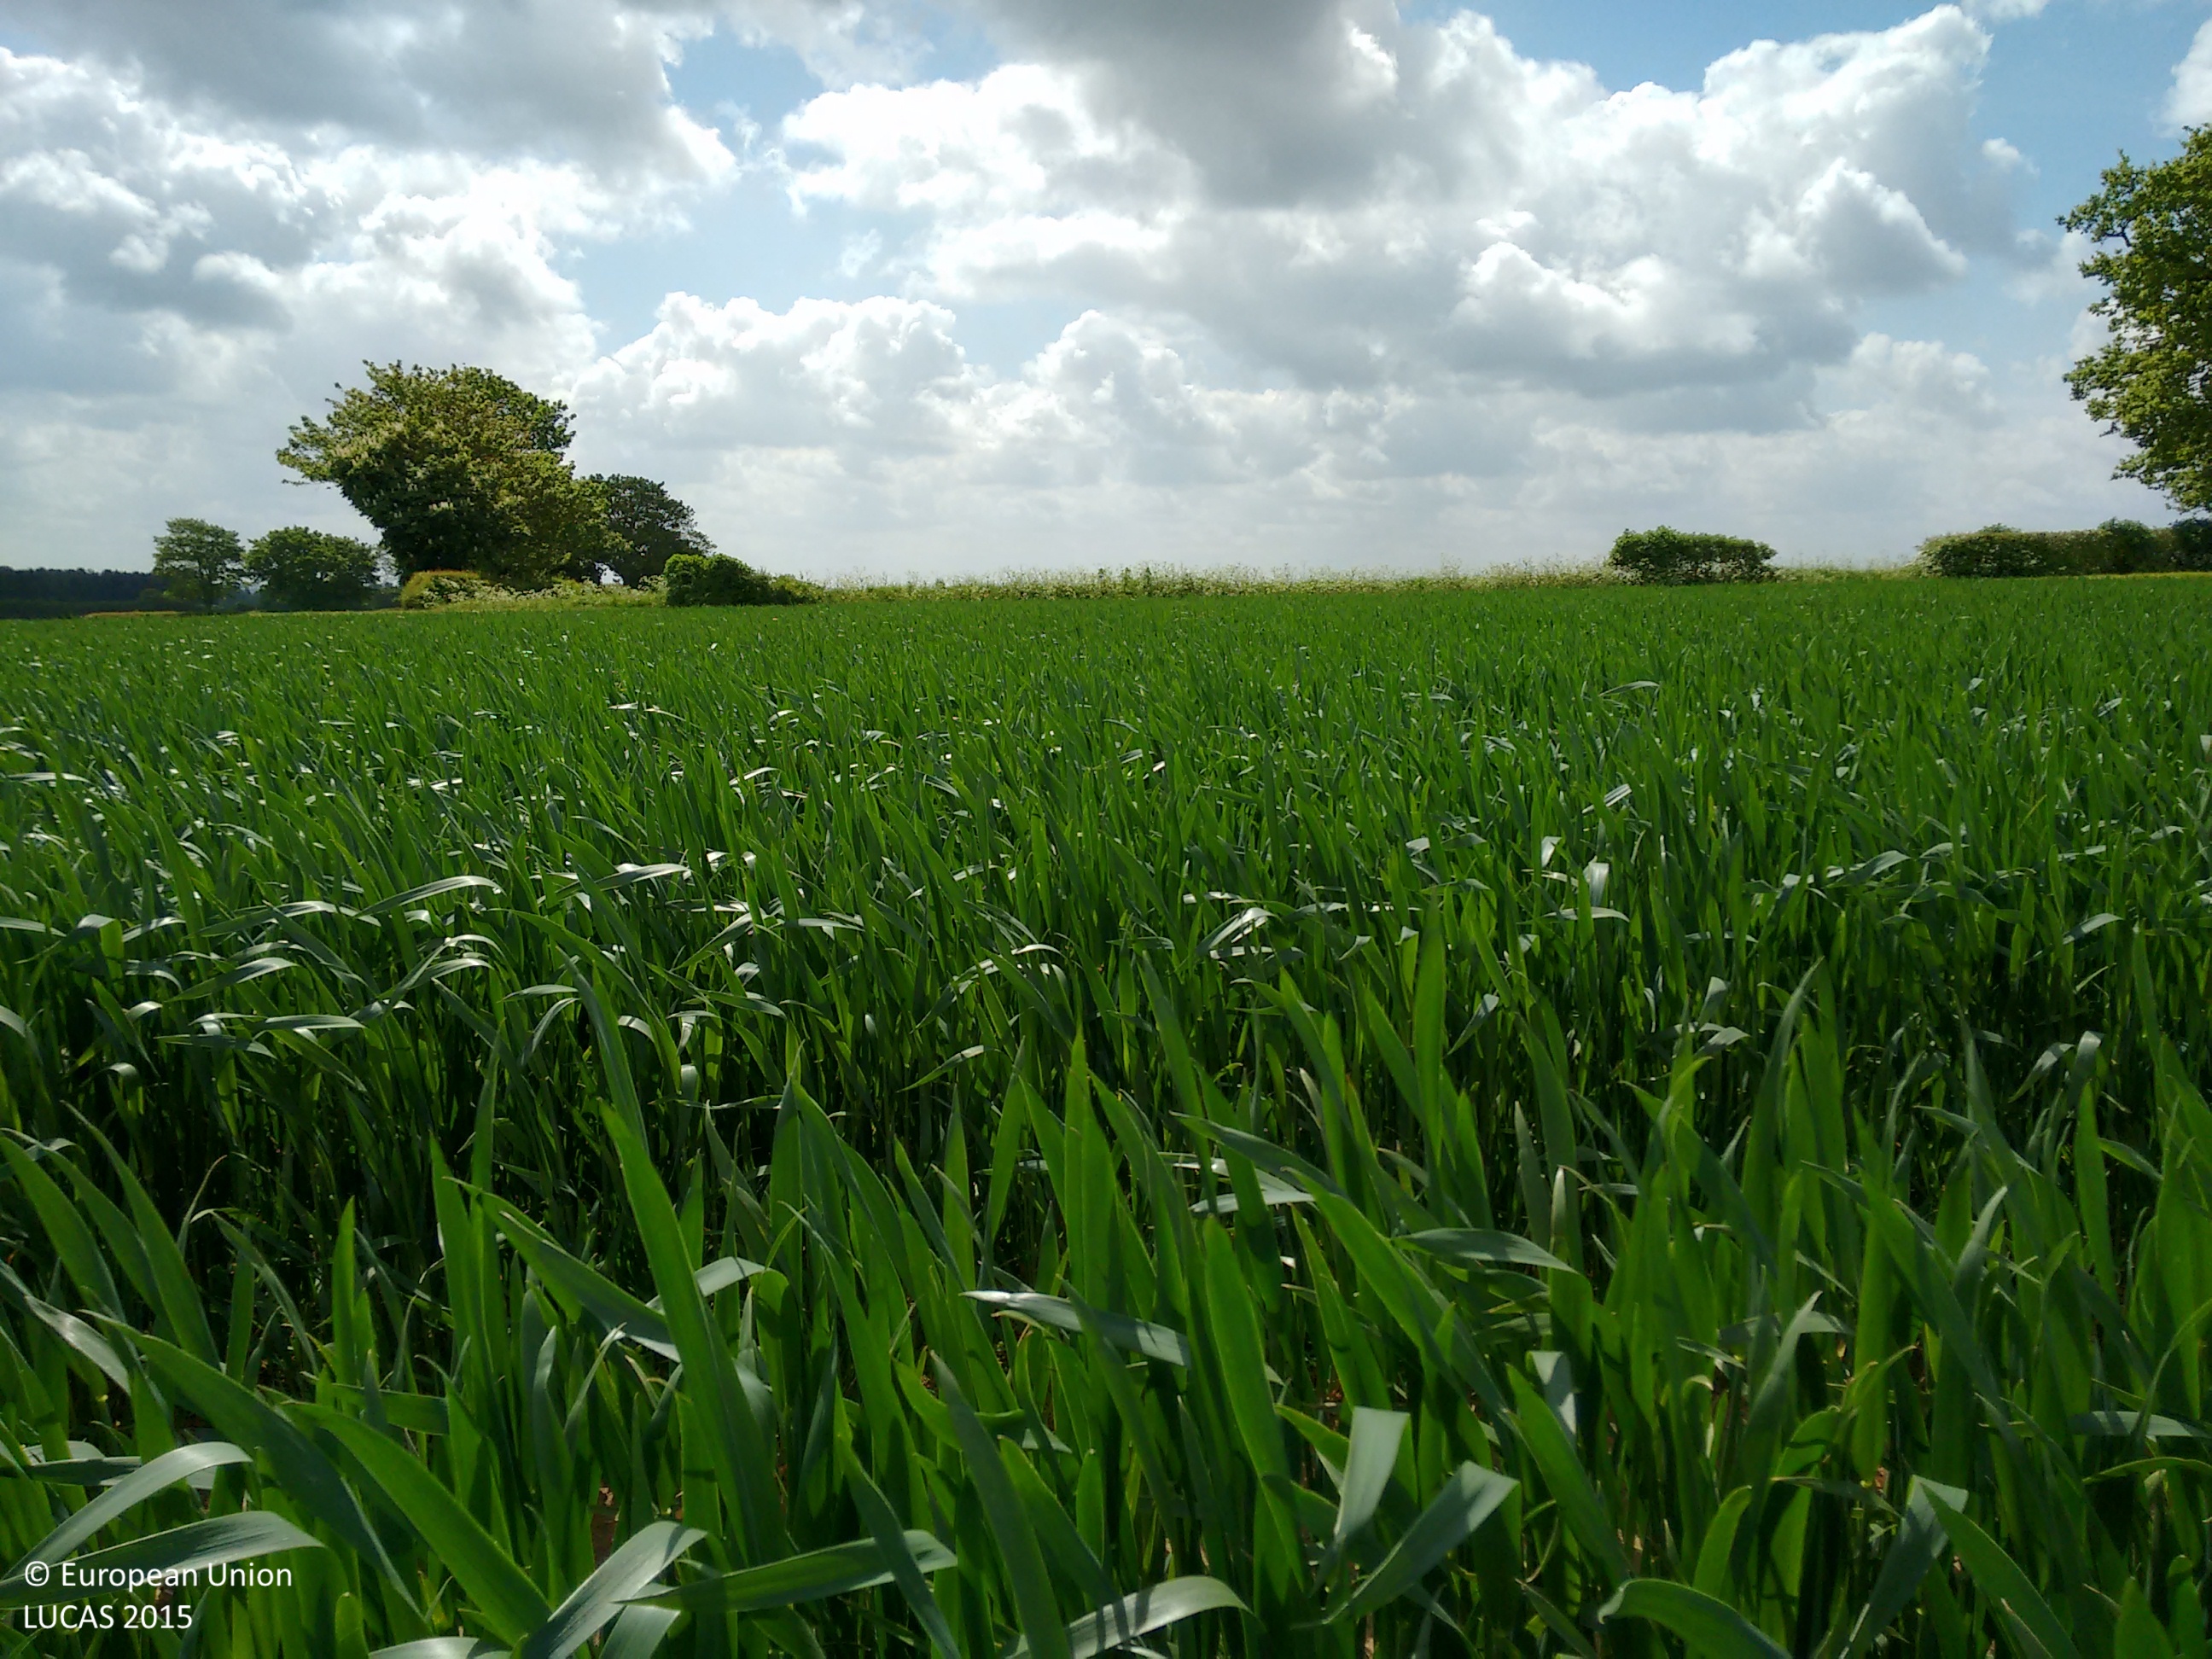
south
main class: Cropland
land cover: Common wheat
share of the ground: > 75 %
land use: Agriculture (excluding fallow land and kitchen gardens)
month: May
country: GB
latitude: 52.0536
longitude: -0.3174
